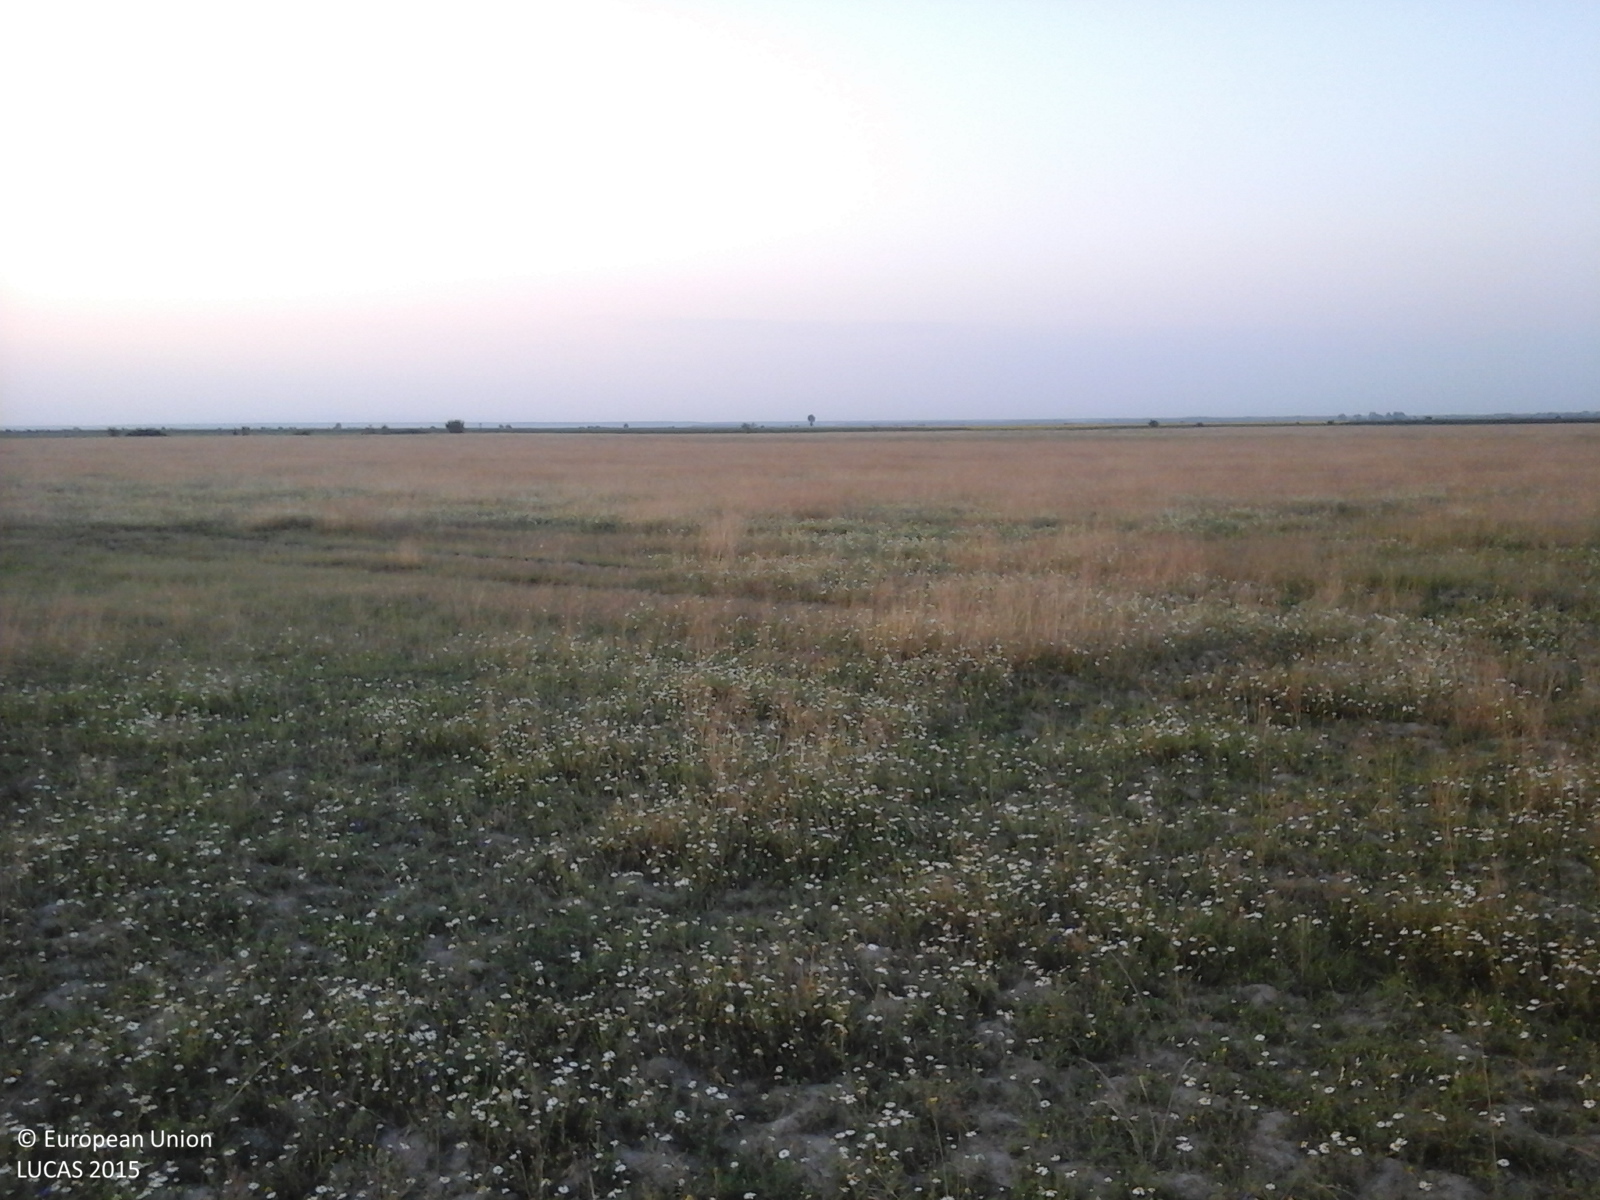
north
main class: Grassland
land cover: Grassland without tree/shrub cover
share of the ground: > 75 %
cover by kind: herbaceous plants 100 %
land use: Agriculture (excluding fallow land and kitchen gardens)
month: July
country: RO
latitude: 44.7318
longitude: 25.7704
